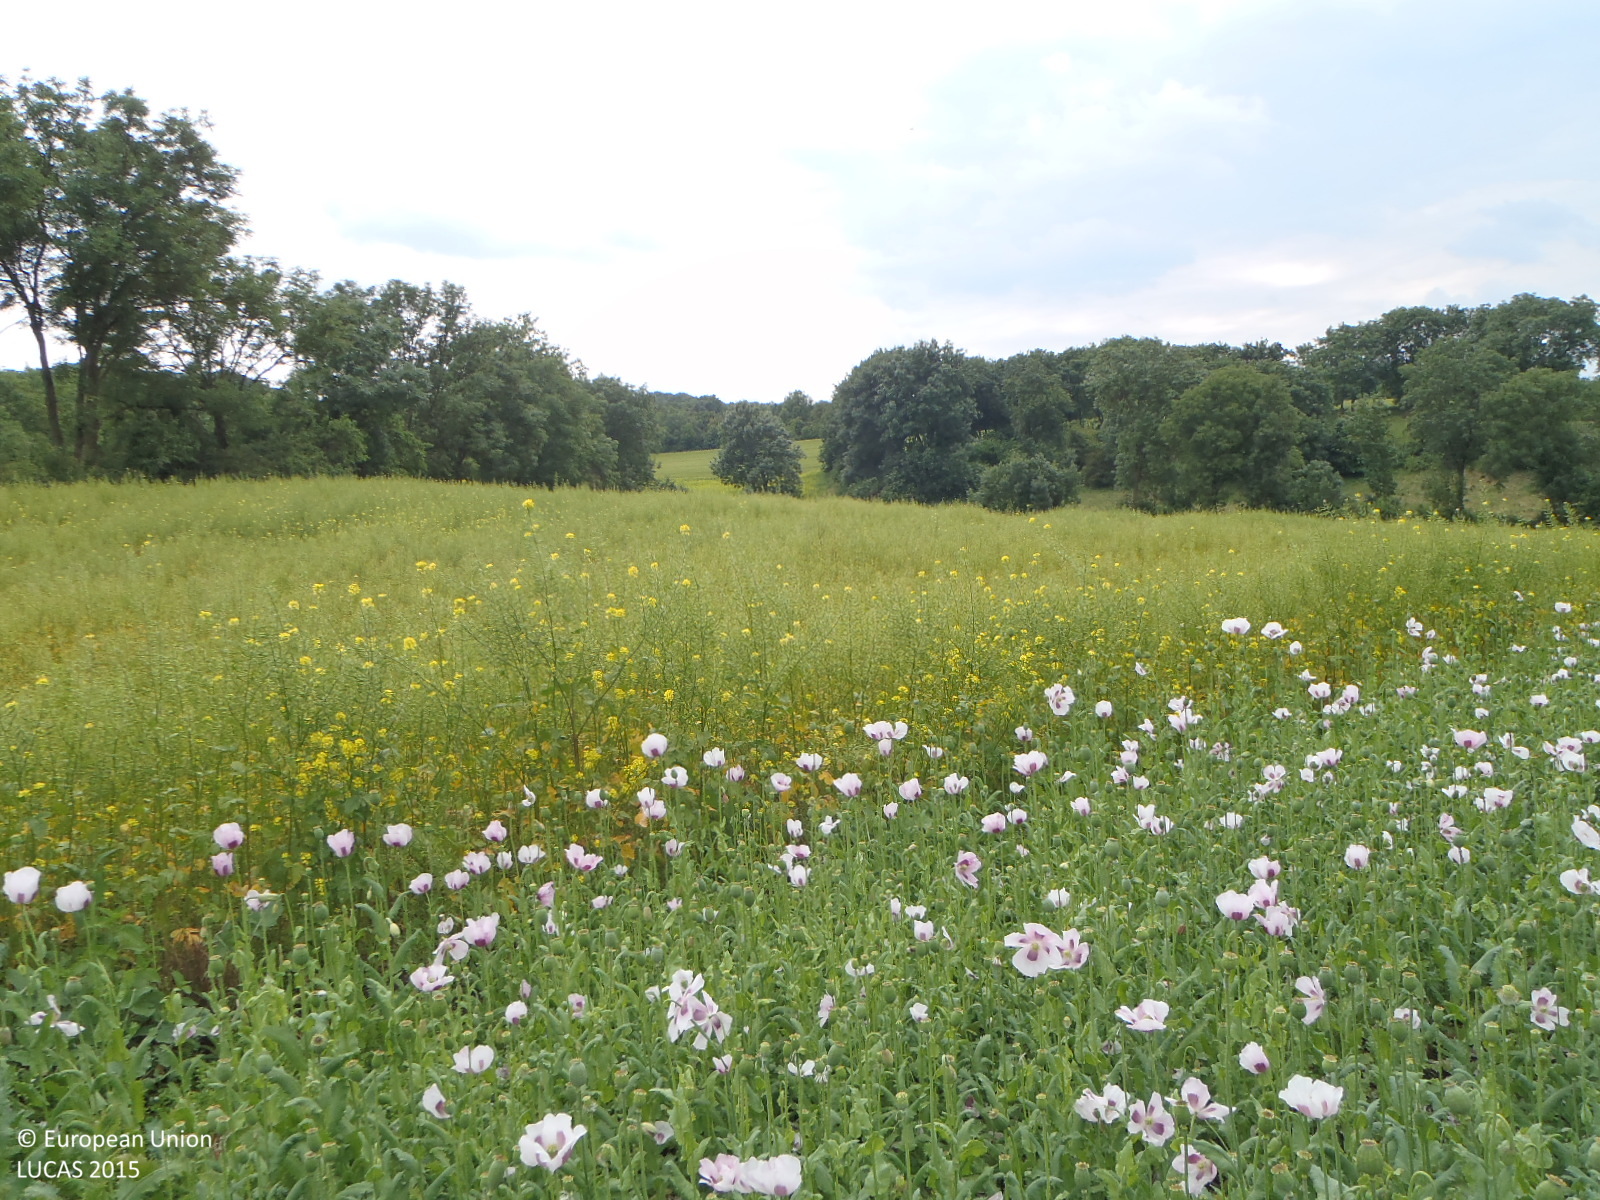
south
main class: Cropland
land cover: Other fibre and oleaginous crops
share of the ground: > 75 %
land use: Agriculture (excluding fallow land and kitchen gardens)
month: June
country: CZ
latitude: 50.4265
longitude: 13.8154
